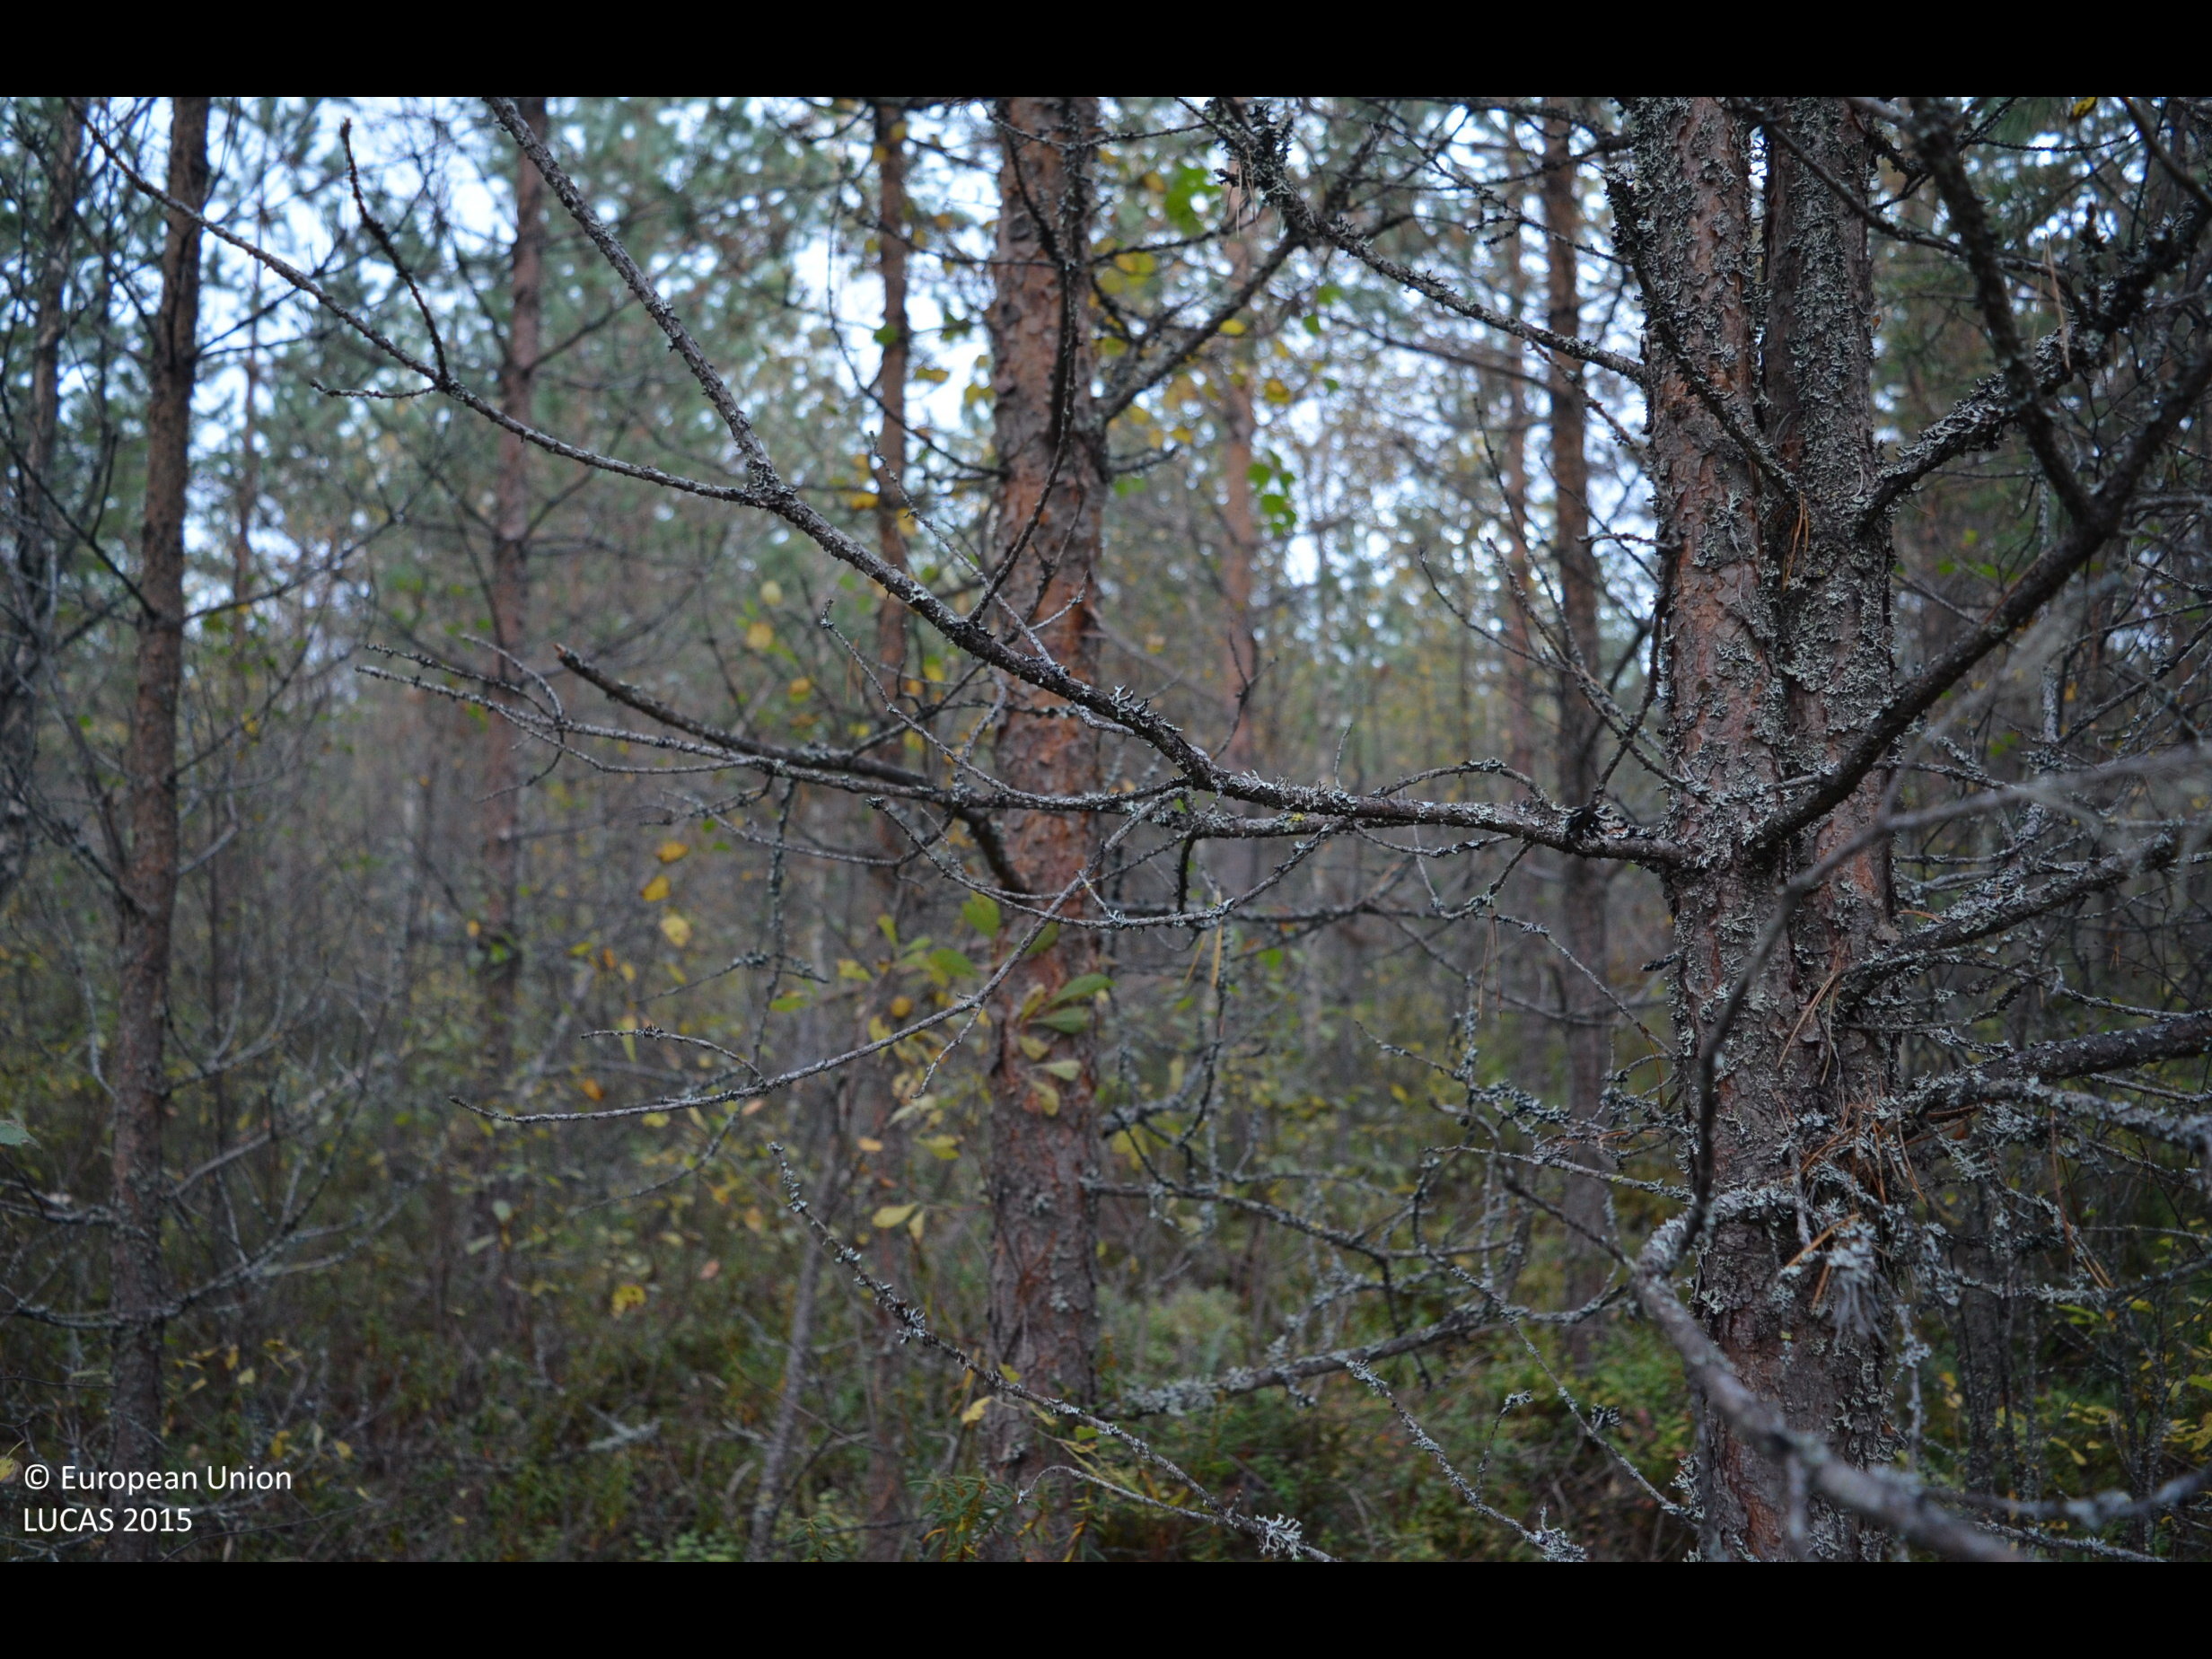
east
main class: Woodland
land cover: Pine dominated mixed woodland
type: boreal forest
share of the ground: > 75 %
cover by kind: coniferous forest trees 55 %, broadleaved forest trees 30 %, shrubs 15 %
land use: Forestry
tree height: > 5 m
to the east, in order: Pine dominated mixed woodland; Ditches and canals; Pine dominated mixed woodland; Pine dominated coniferous woodland; Pine dominated mixed woodland; Pine dominated coniferous woodland; Ditches and canals; Pine dominated mixed woodland
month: September
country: FI
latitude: 62.8150
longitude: 23.8273
